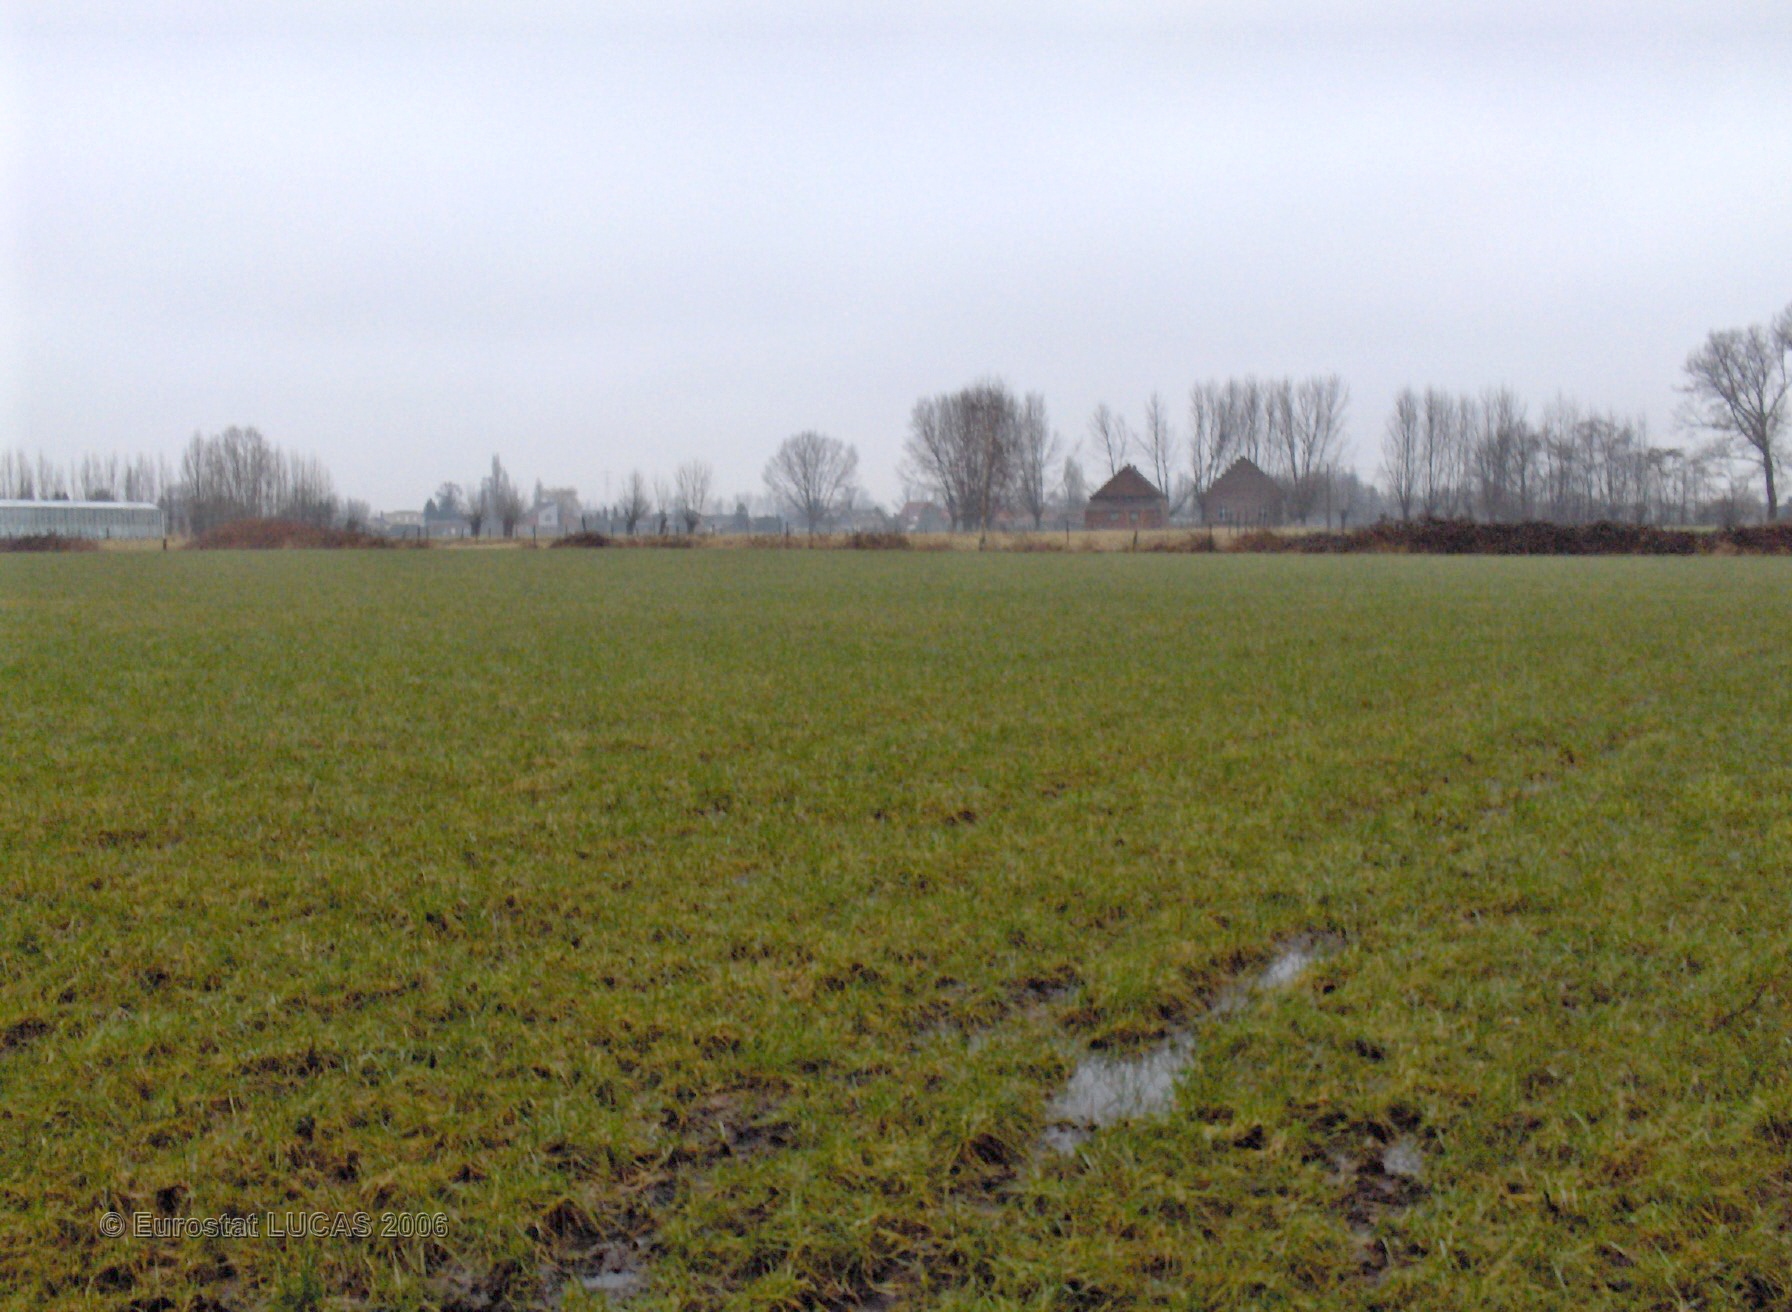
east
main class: Grassland
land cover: Grassland without tree/shrub cover
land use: Agriculture (excluding fallow land and kitchen gardens)
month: March
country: BE
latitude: 51.0954
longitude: 4.4697
